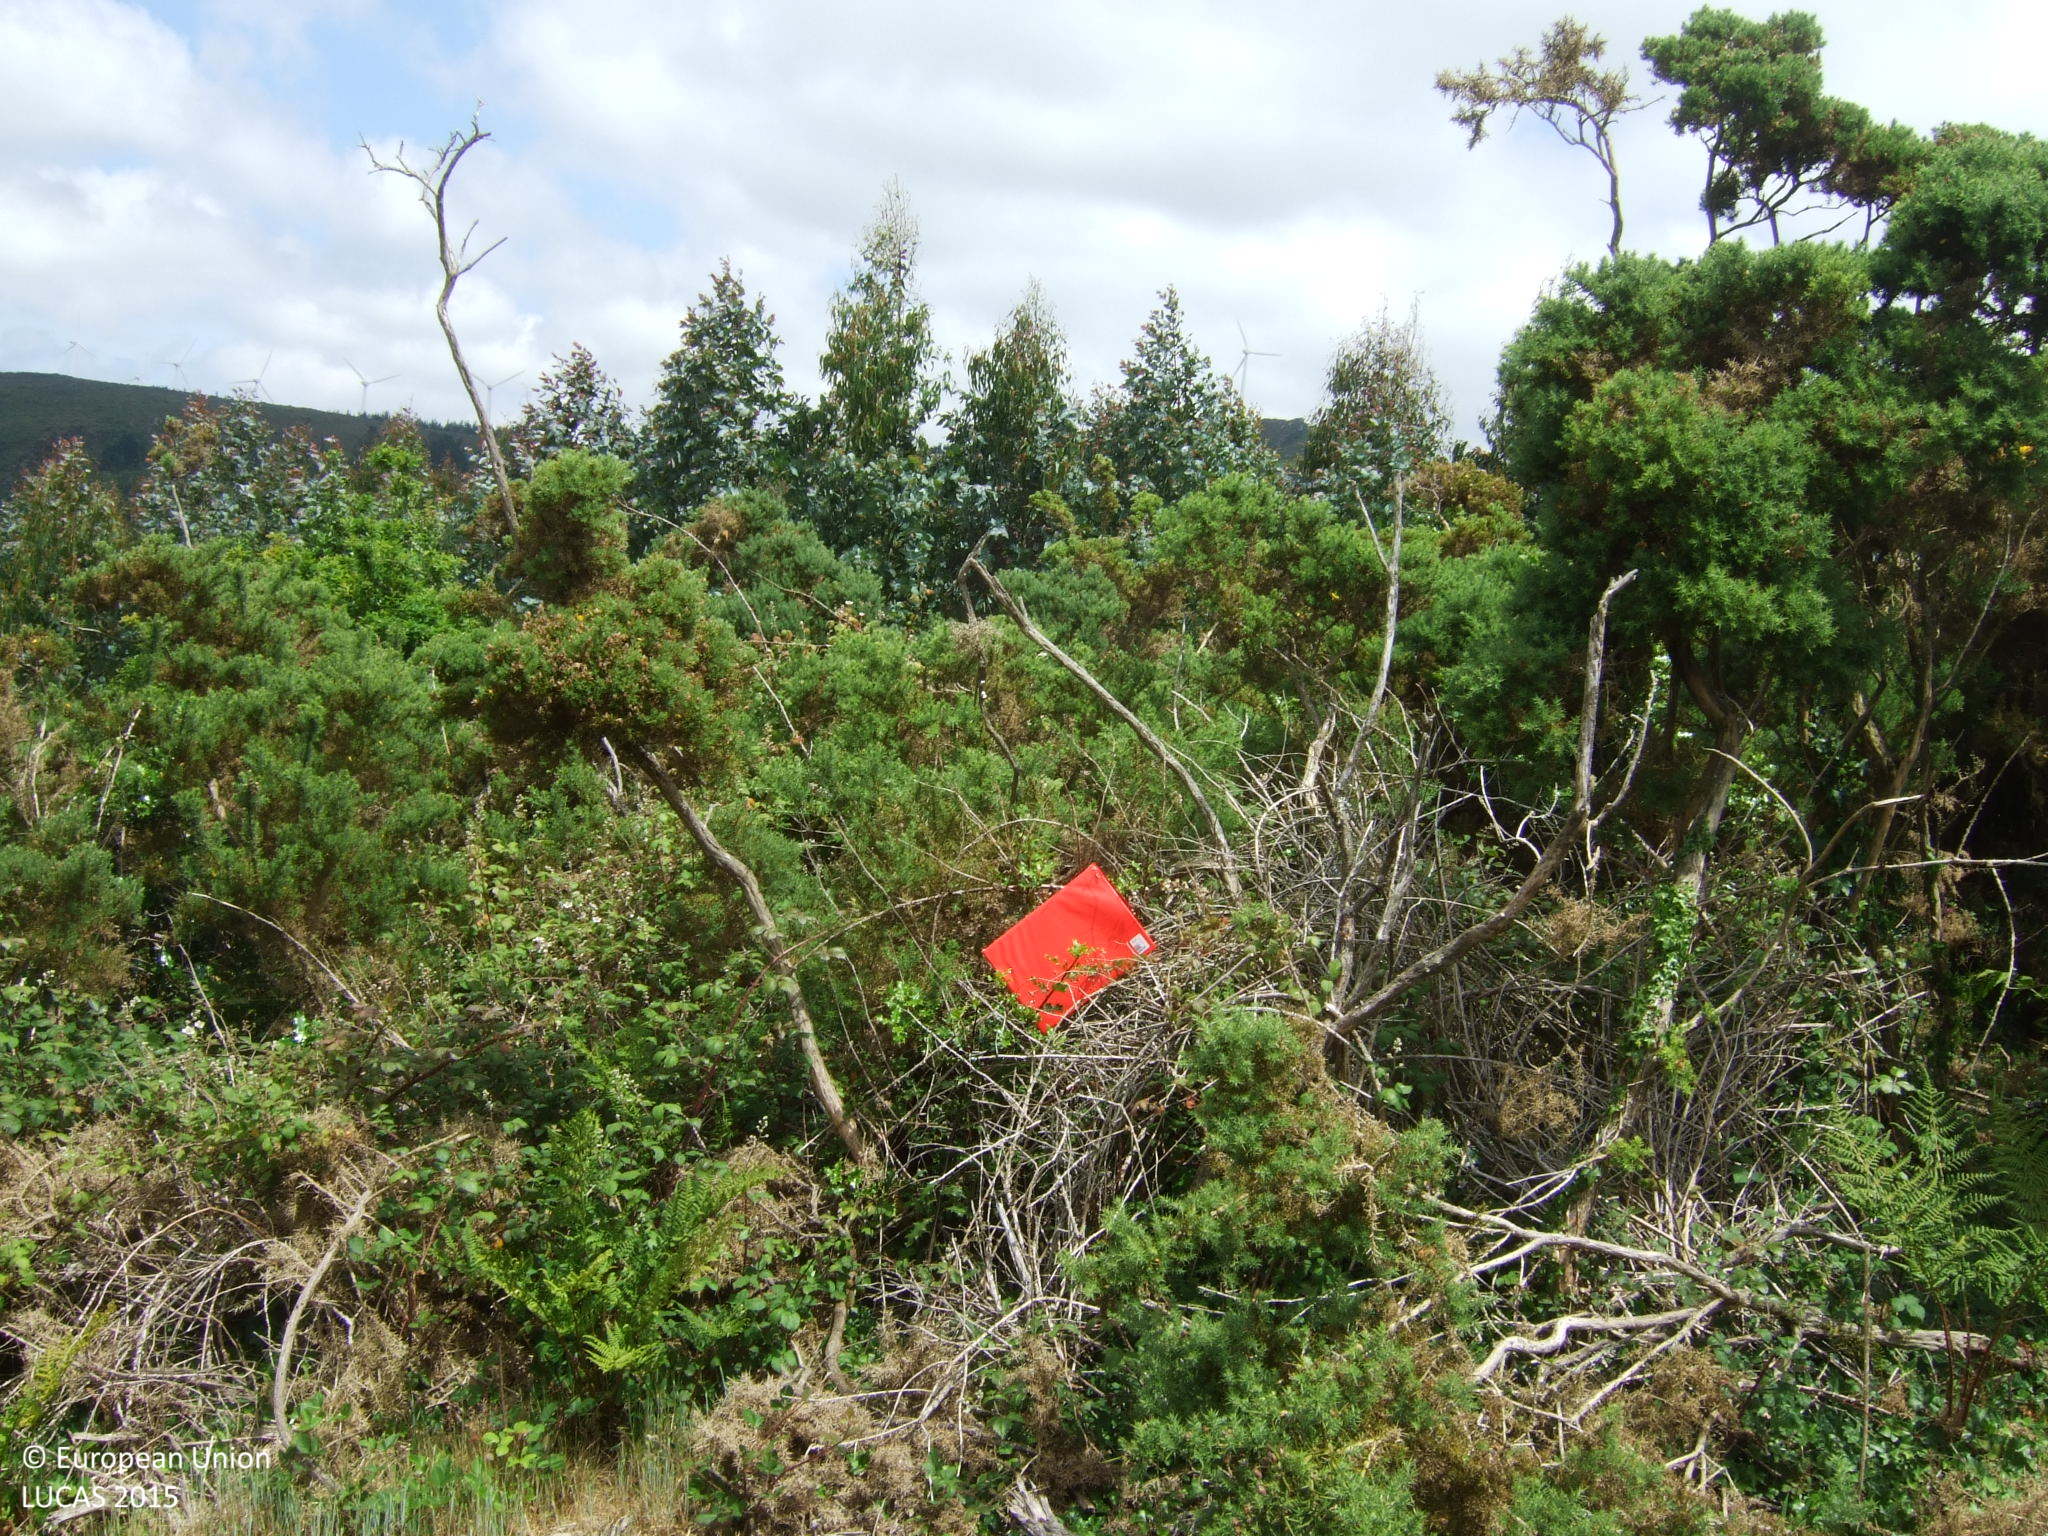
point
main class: Shrubland
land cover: Shrubland with sparse tree cover
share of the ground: > 75 %
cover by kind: shrubs 95 %, broadleaved forest trees 5 %
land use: Semi-natural and natural areas not in use
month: June
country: ES
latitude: 43.5298
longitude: -7.8225
